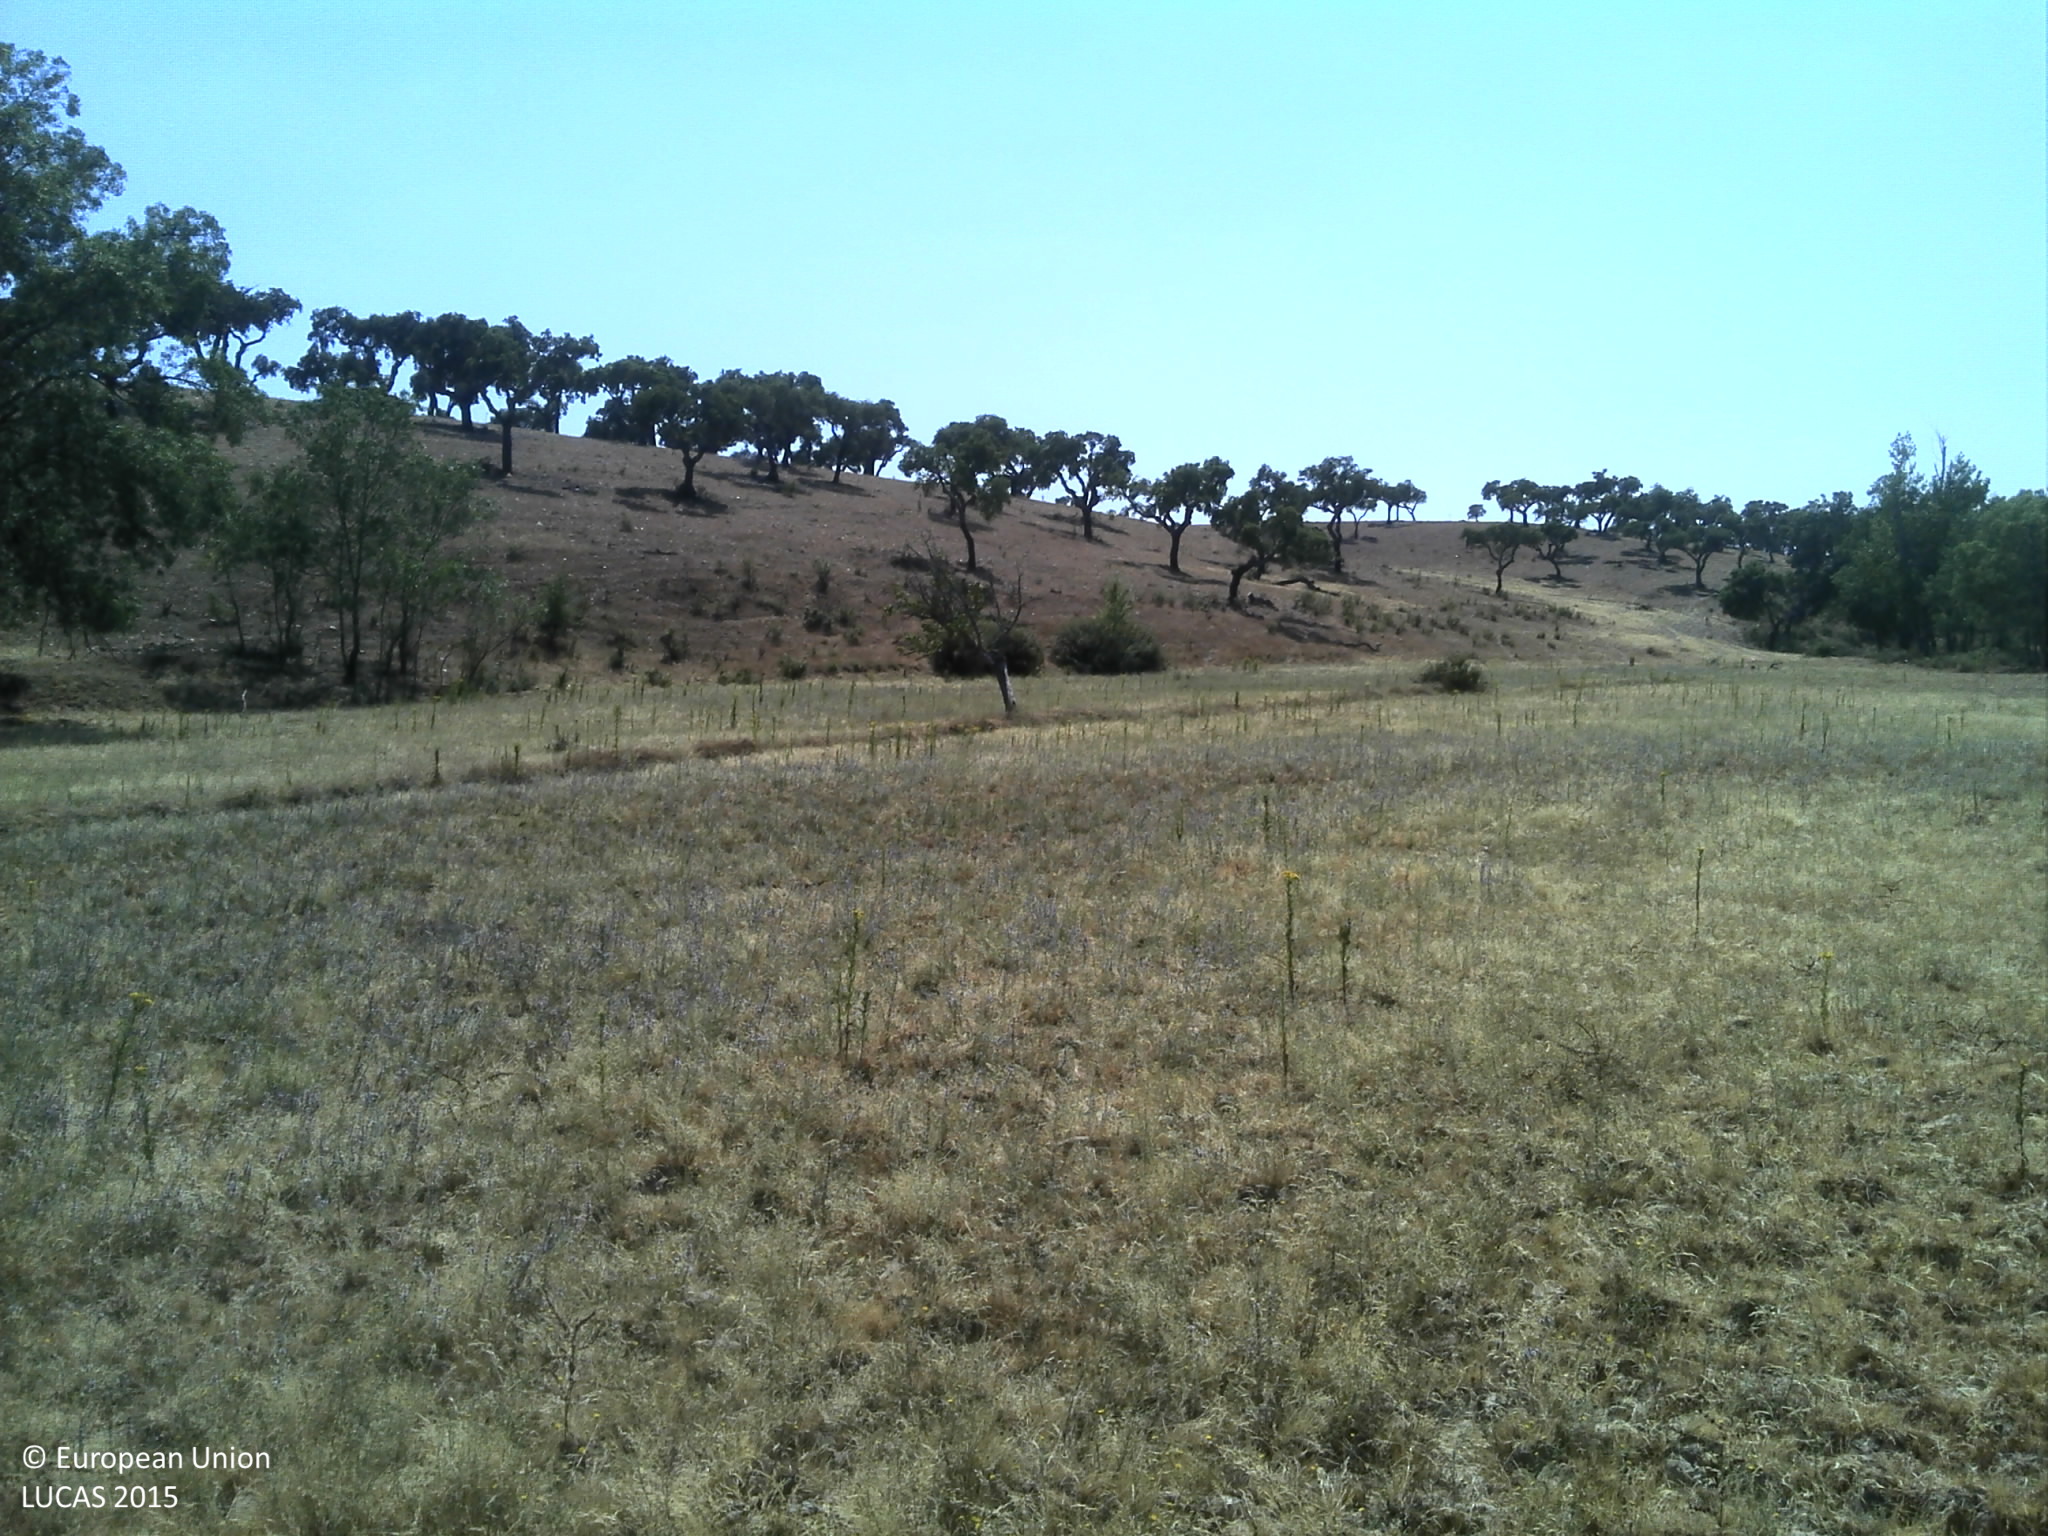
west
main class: Grassland
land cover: Grassland without tree/shrub cover
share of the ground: 50 - 75 %
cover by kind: herbaceous plants 65 %, unconsolidated bare surface 35 %
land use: Agriculture (excluding fallow land and kitchen gardens)
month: June
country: PT
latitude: 40.0254
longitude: -6.9994
